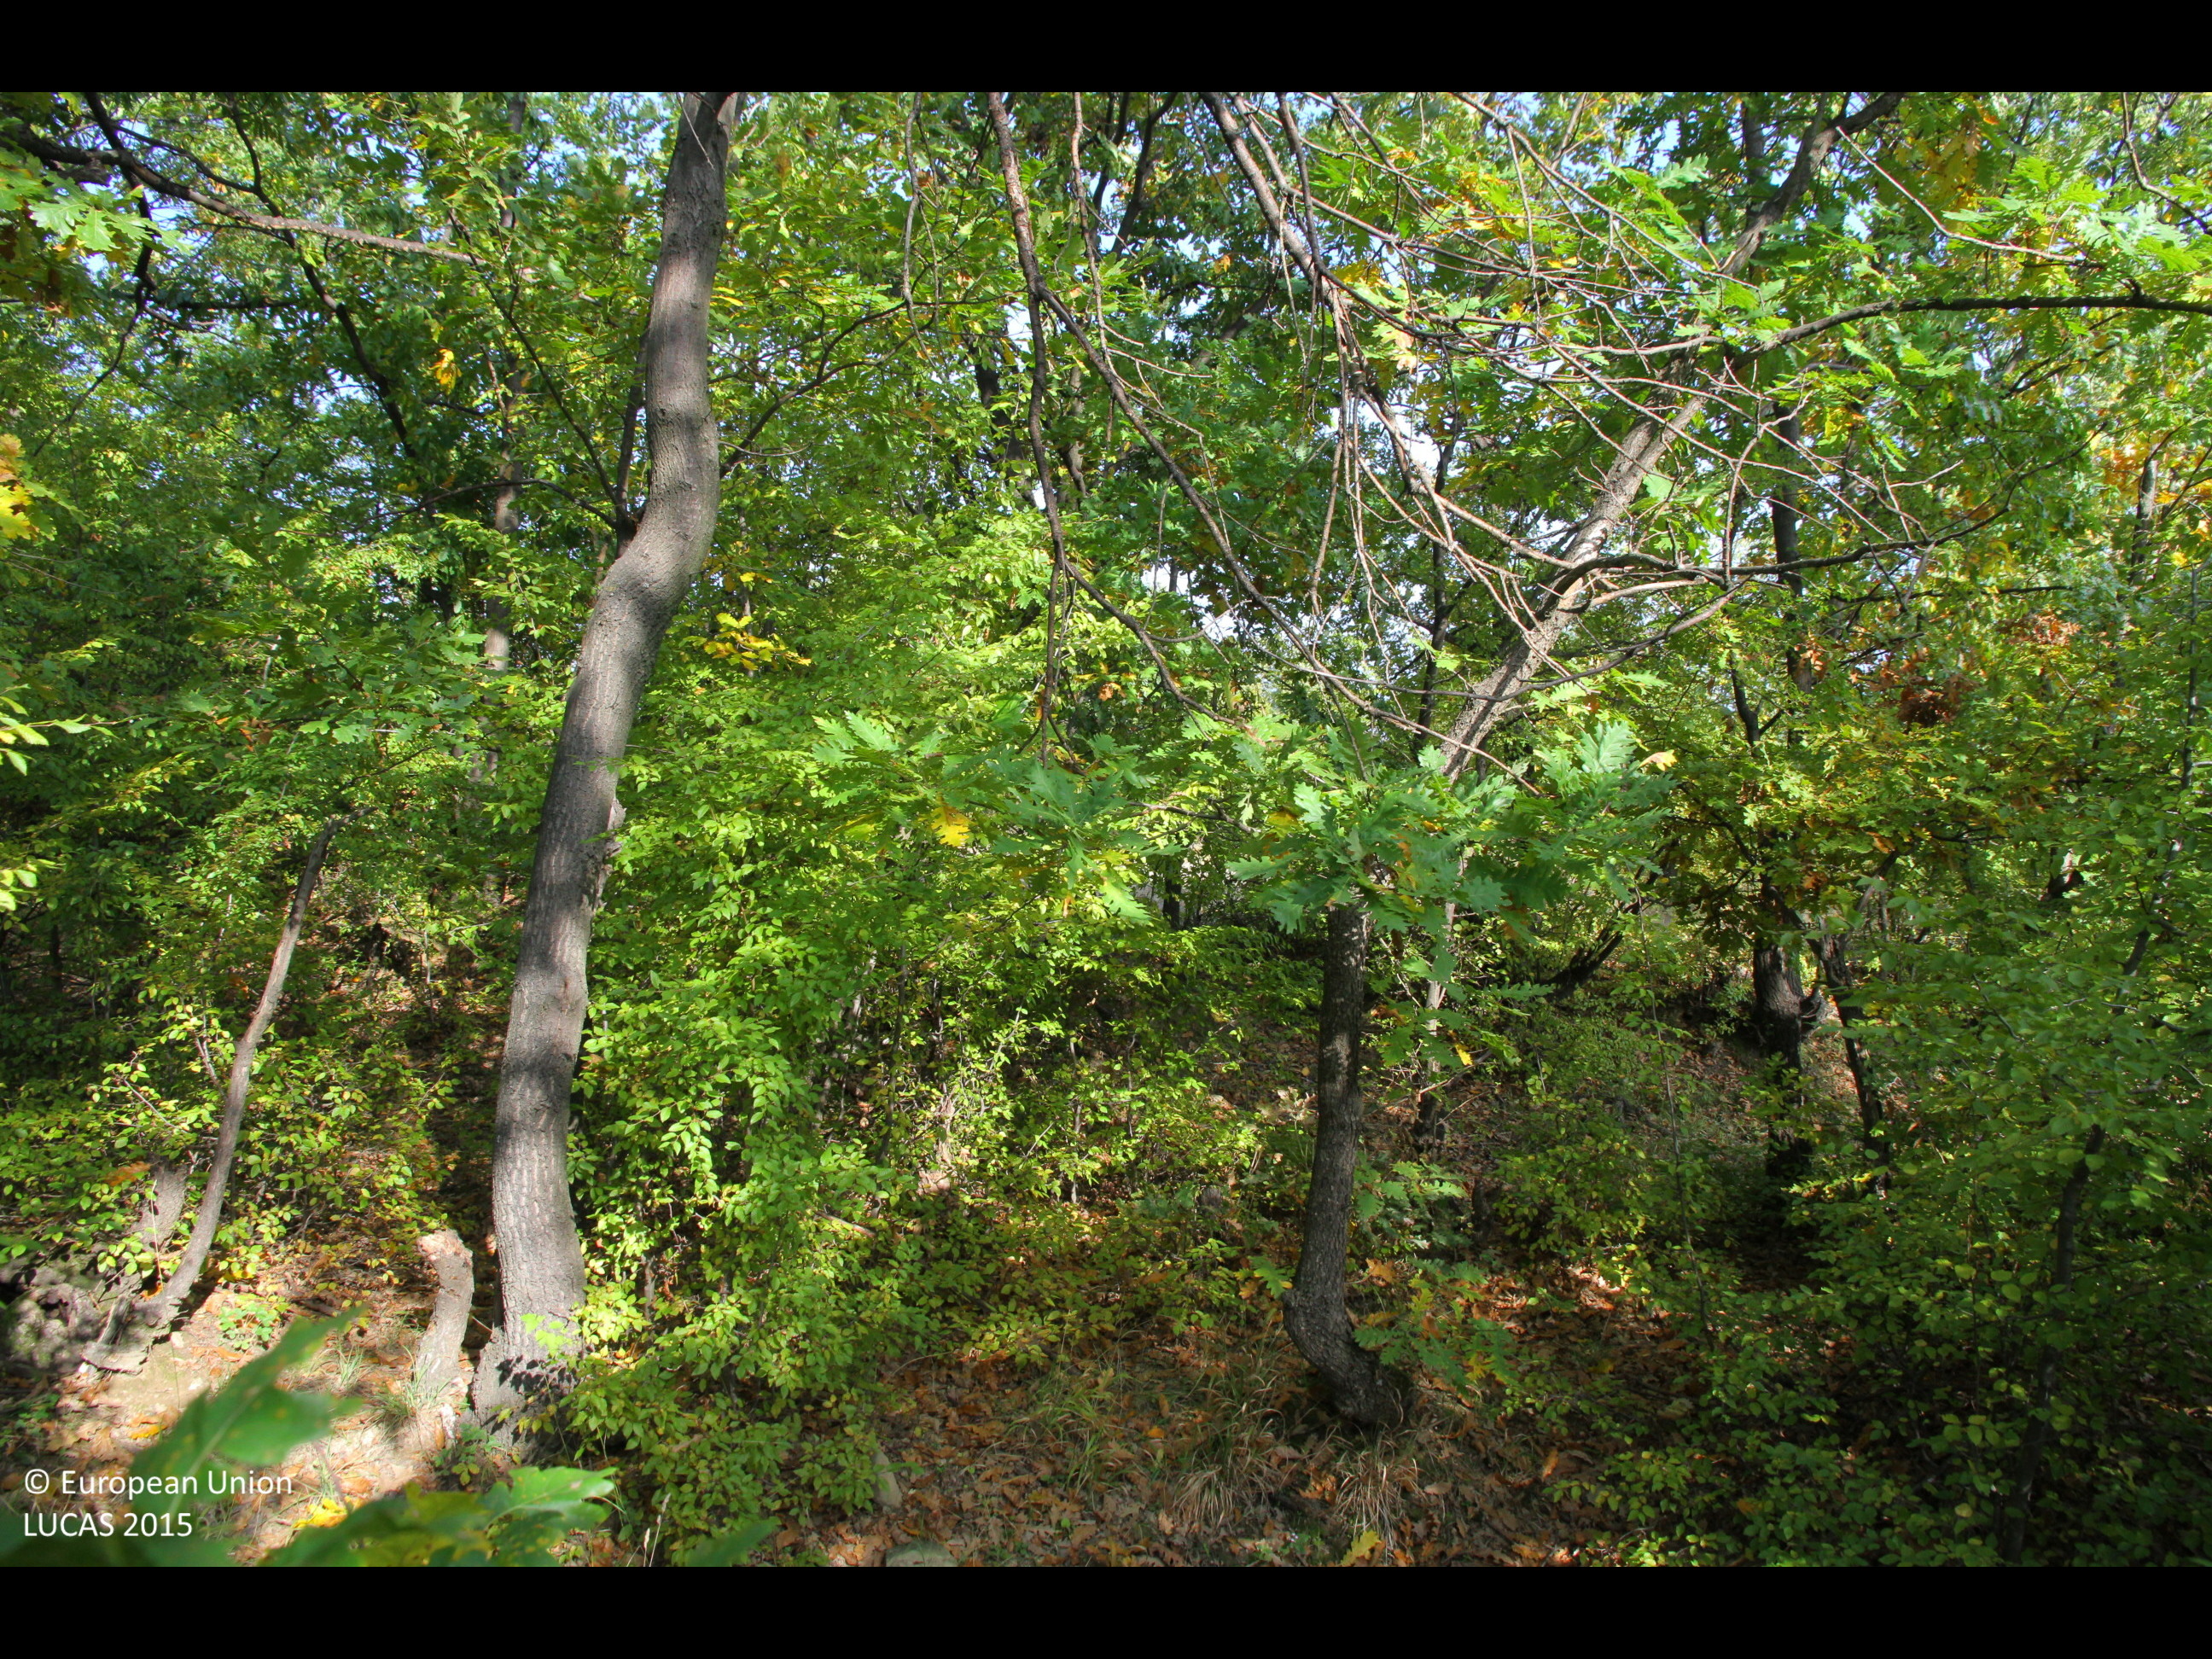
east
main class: Woodland
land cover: Broadleaved woodland
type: thermophilous deciduous forest
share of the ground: > 75 %
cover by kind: broadleaved forest trees 90 %, herbaceous plants 5 %, unconsolidated bare surface 5 %
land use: Forestry
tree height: > 5 m
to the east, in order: Broadleaved woodland; Tracks; Grassland with sparse tree/shrub cover; Broadleaved woodland; Other bare soil; Broadleaved woodland; Shrubland with sparse tree cover
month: October
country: BG
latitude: 42.9676
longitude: 26.9175
